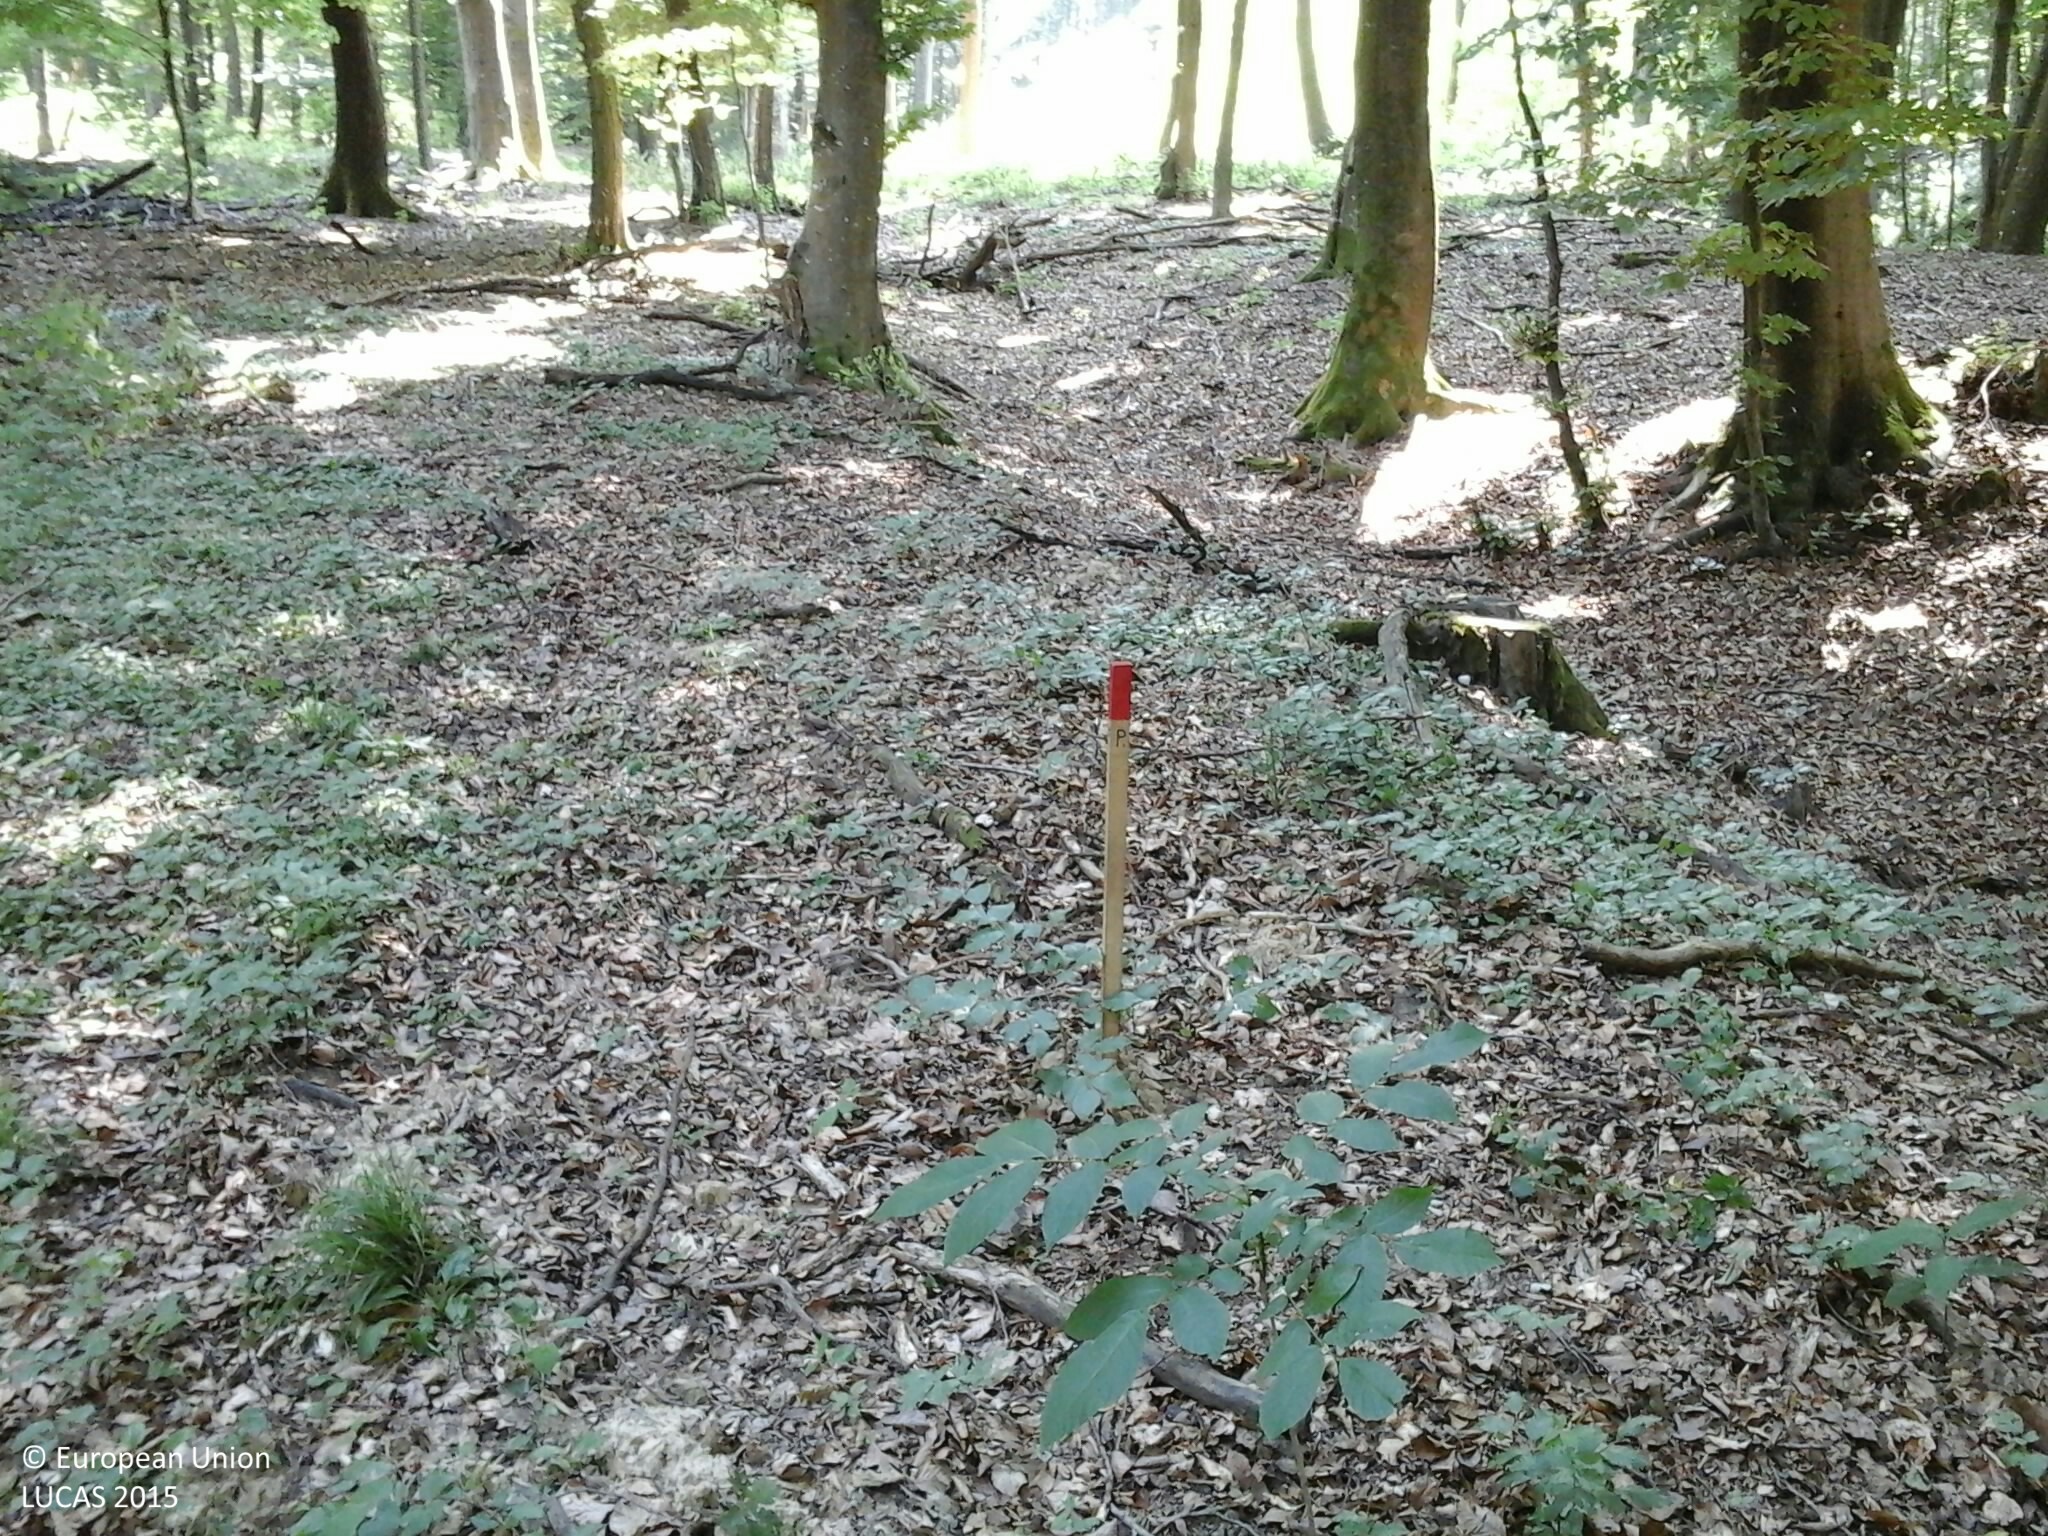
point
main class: Woodland
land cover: Spruce dominated coniferous woodland
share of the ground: > 75 %
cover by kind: coniferous forest trees 90 %, broadleaved forest trees 10 %
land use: Forestry
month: July
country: HU
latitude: 46.9347
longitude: 16.4252
